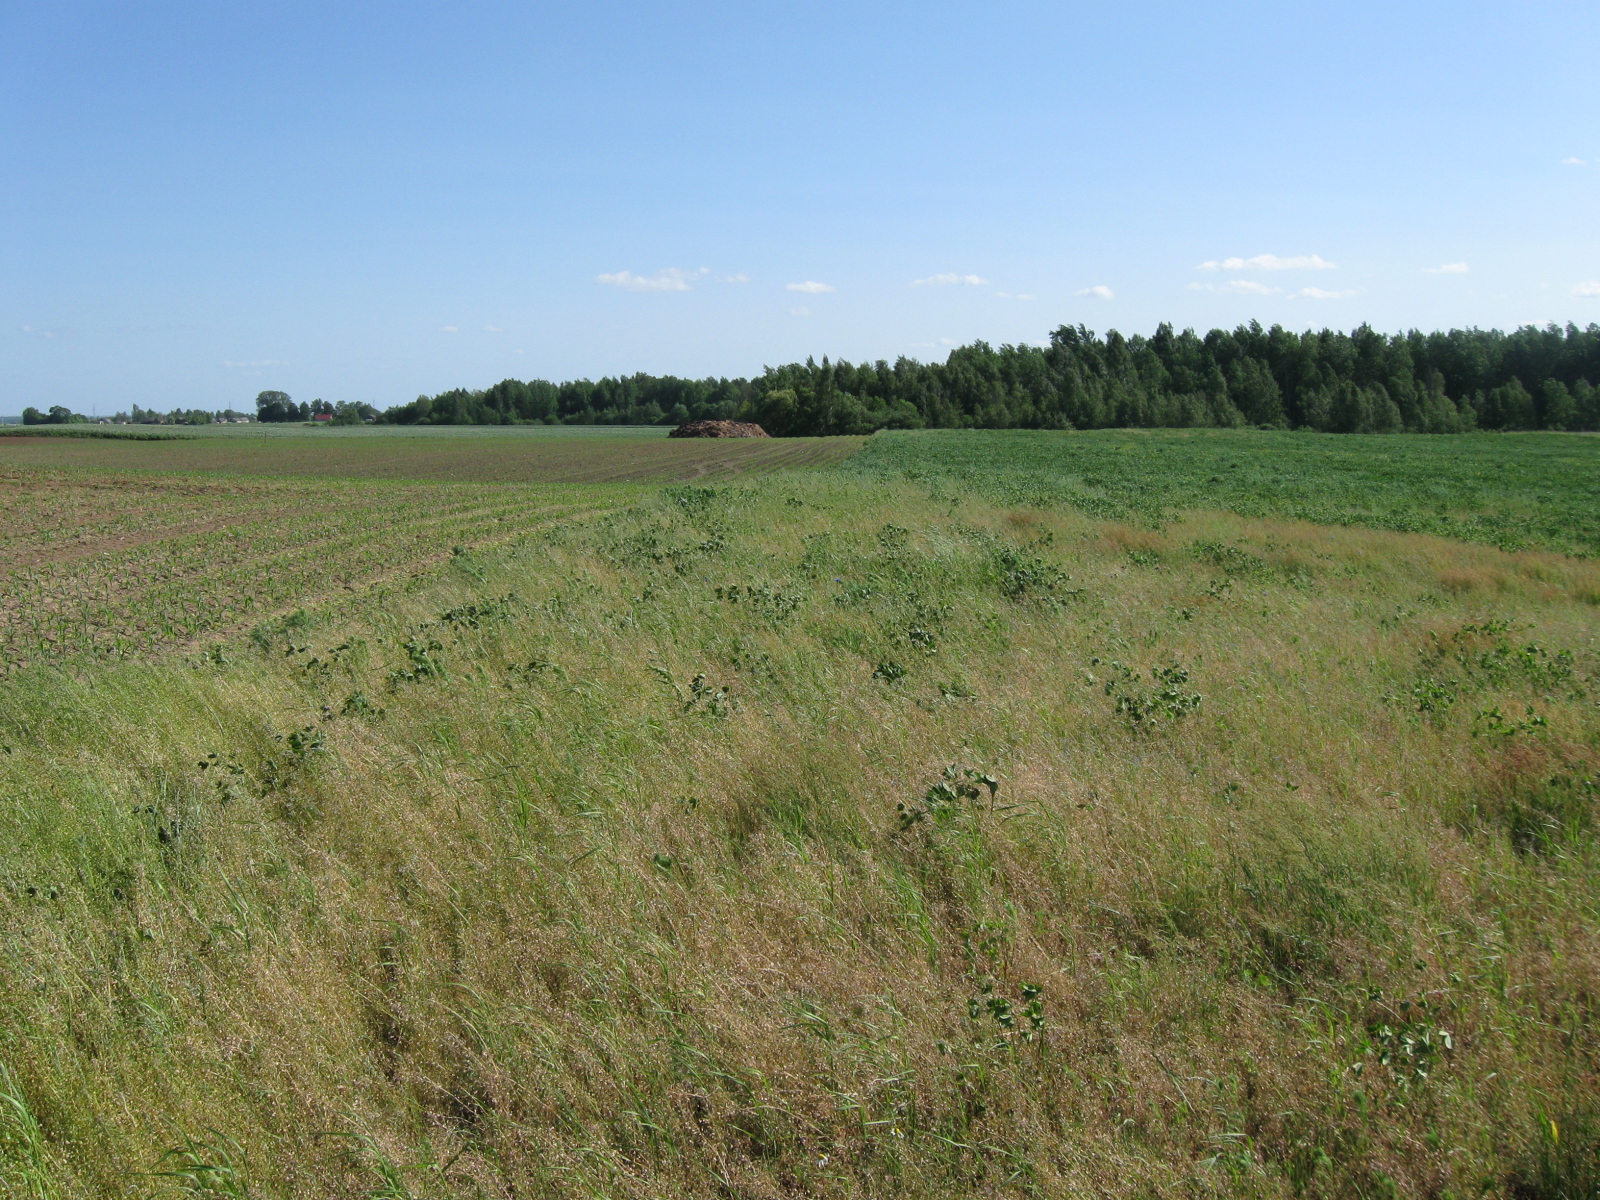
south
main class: Grassland
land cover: Spontaneously vegetated surfaces
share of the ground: > 75 %
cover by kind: herbaceous plants 100 %
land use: Fallow land
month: June
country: LT
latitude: 54.4469
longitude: 23.6717
